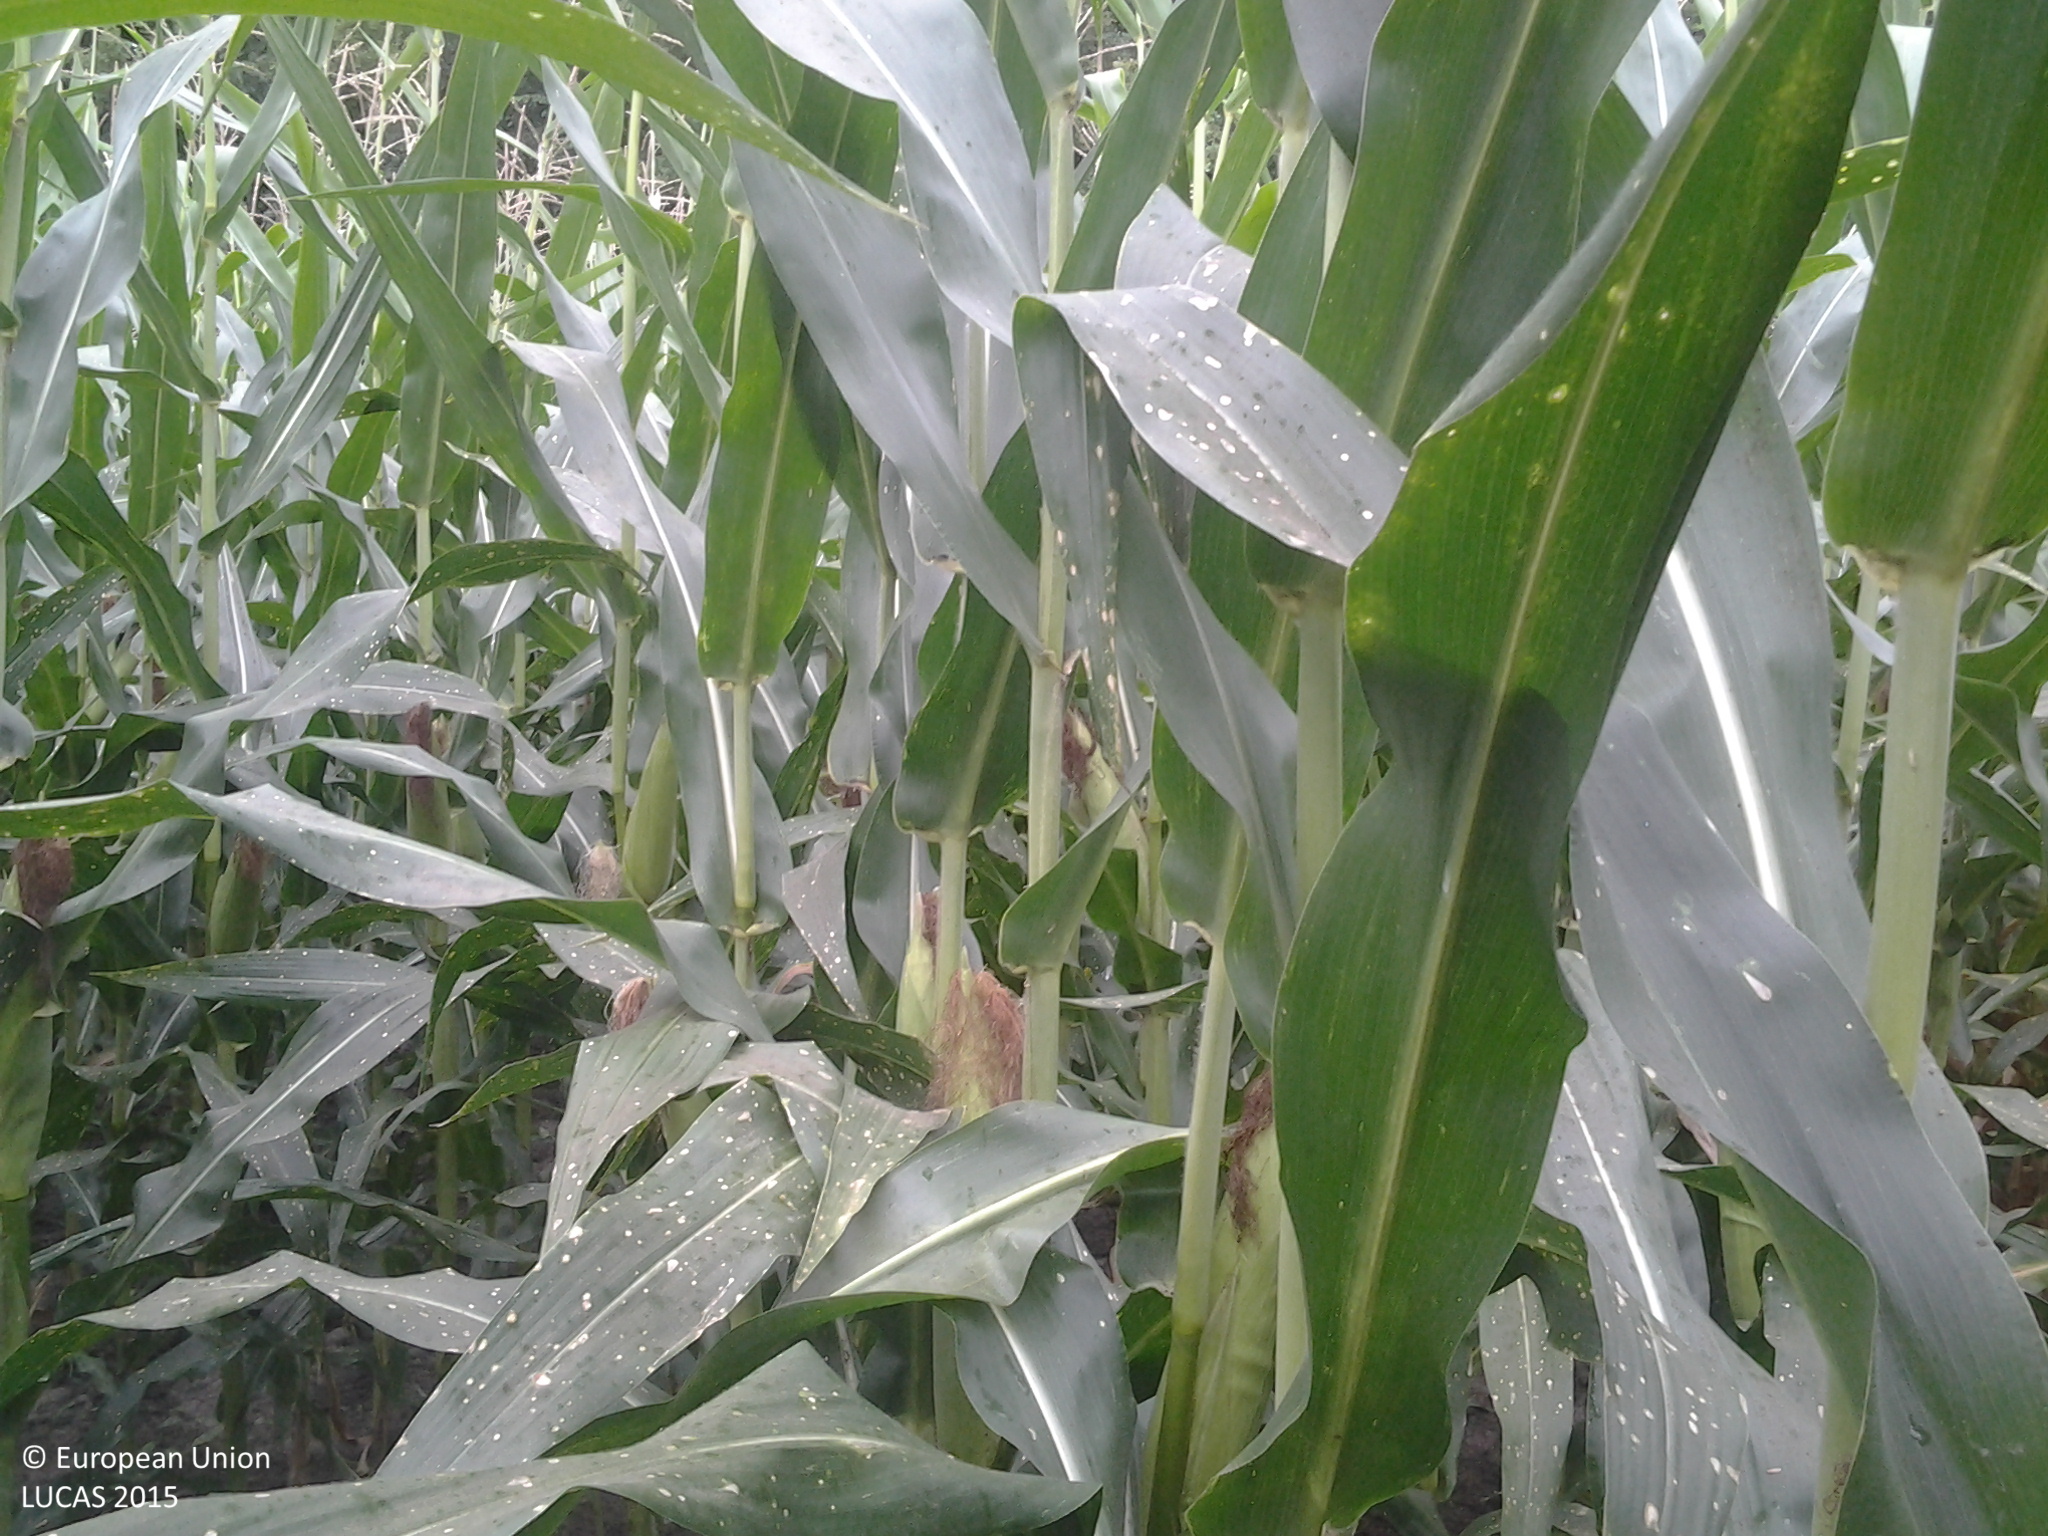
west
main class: Cropland
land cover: Maize
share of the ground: > 75 %
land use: Agriculture (excluding fallow land and kitchen gardens)
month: July
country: HU
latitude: 46.7251
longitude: 19.0825
